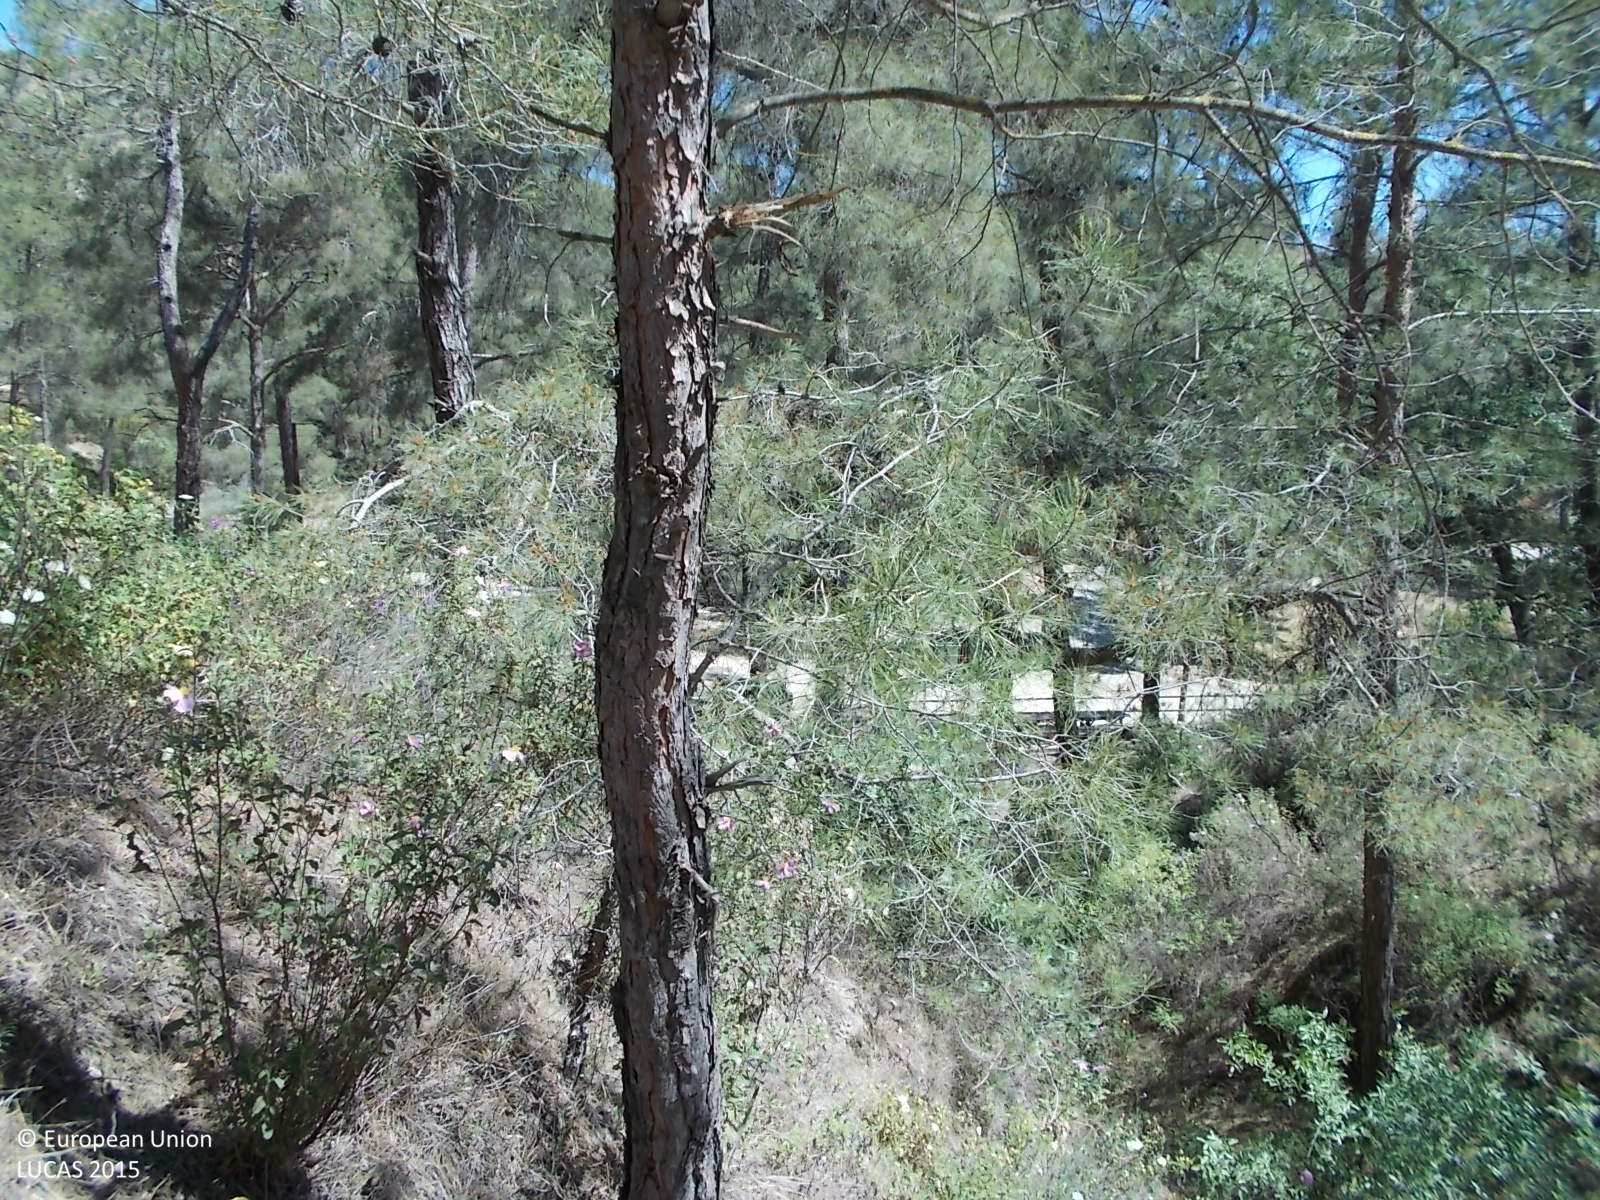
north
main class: Woodland
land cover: Pine dominated coniferous woodland
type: coniferous forest of the mediterranean region
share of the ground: > 75 %
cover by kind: coniferous forest trees 100 %
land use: Amenities, museums, leisure
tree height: > 5 m
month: May
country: CY
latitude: 34.8290
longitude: 33.0097
